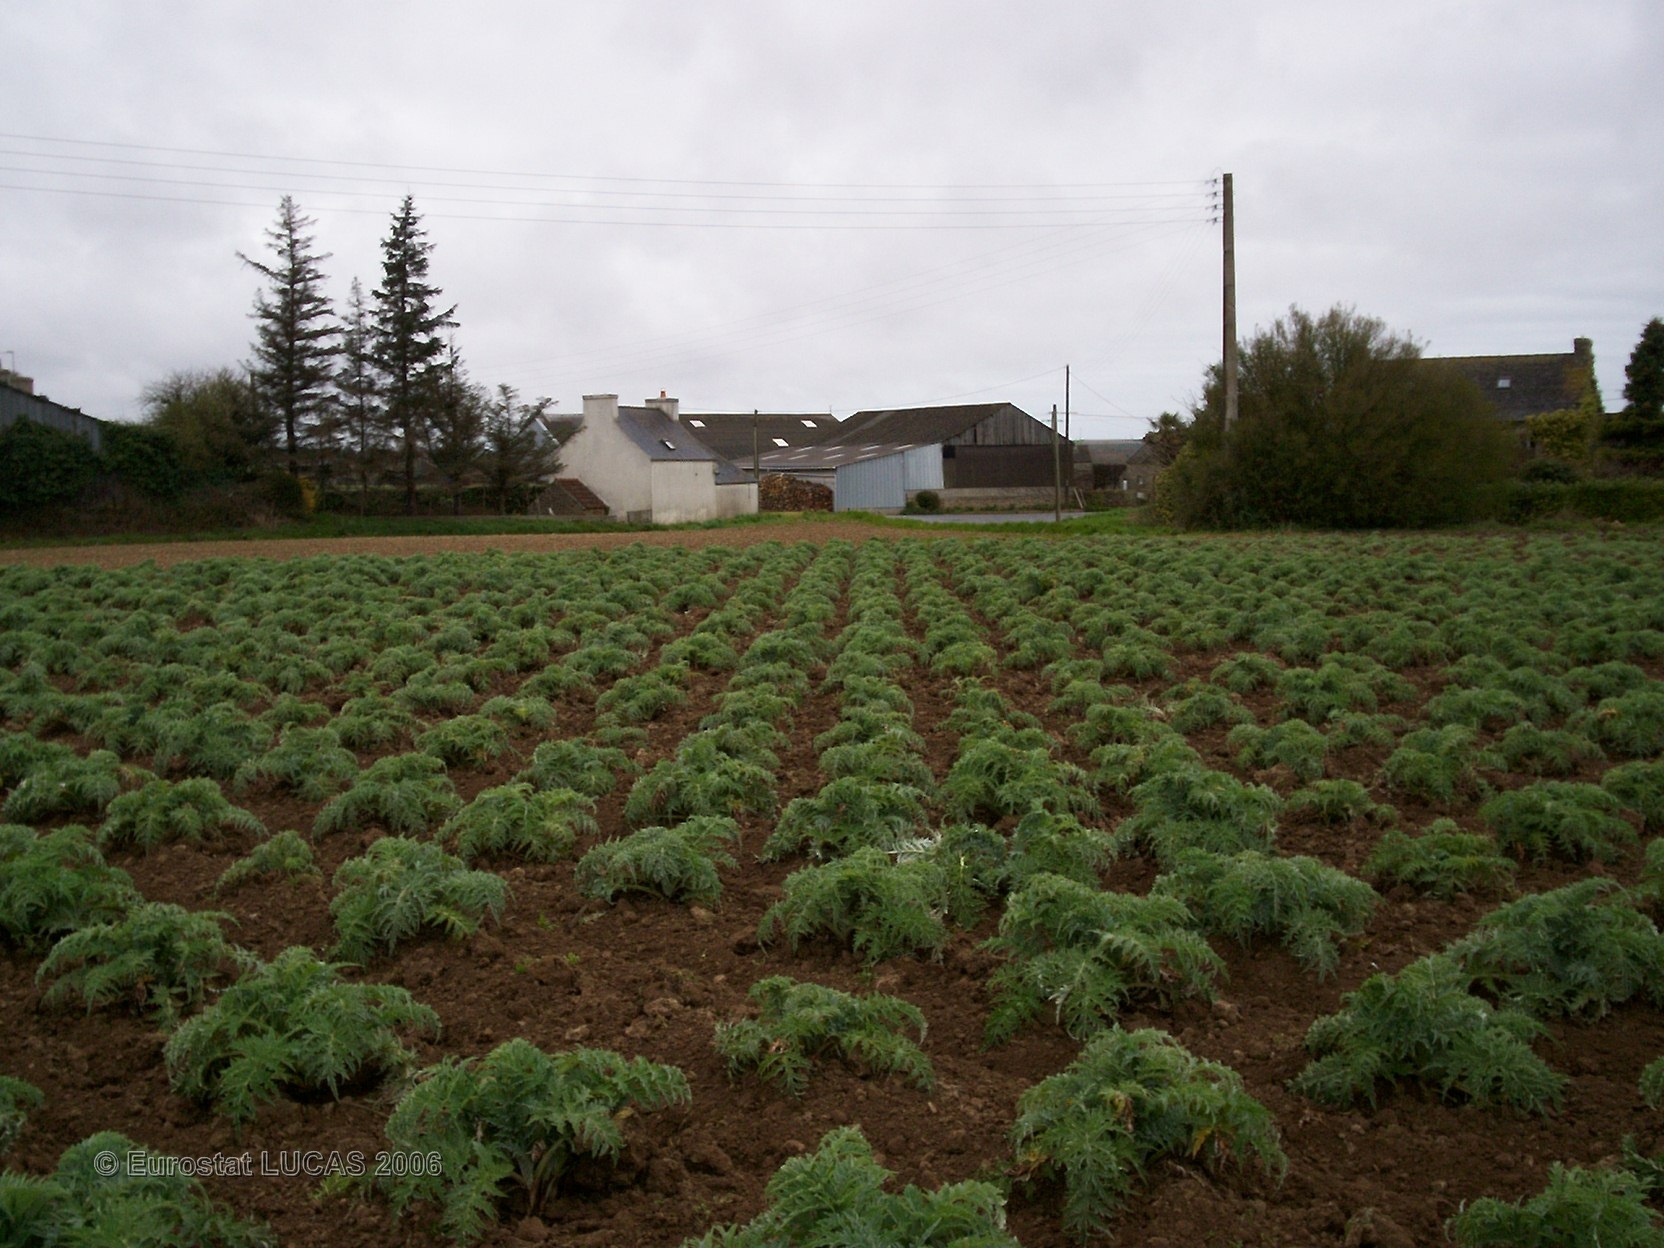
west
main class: Cropland
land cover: Other fresh vegetables
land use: Agriculture (excluding fallow land and kitchen gardens)
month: April
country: FR
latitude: 48.6326
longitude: -4.0529
